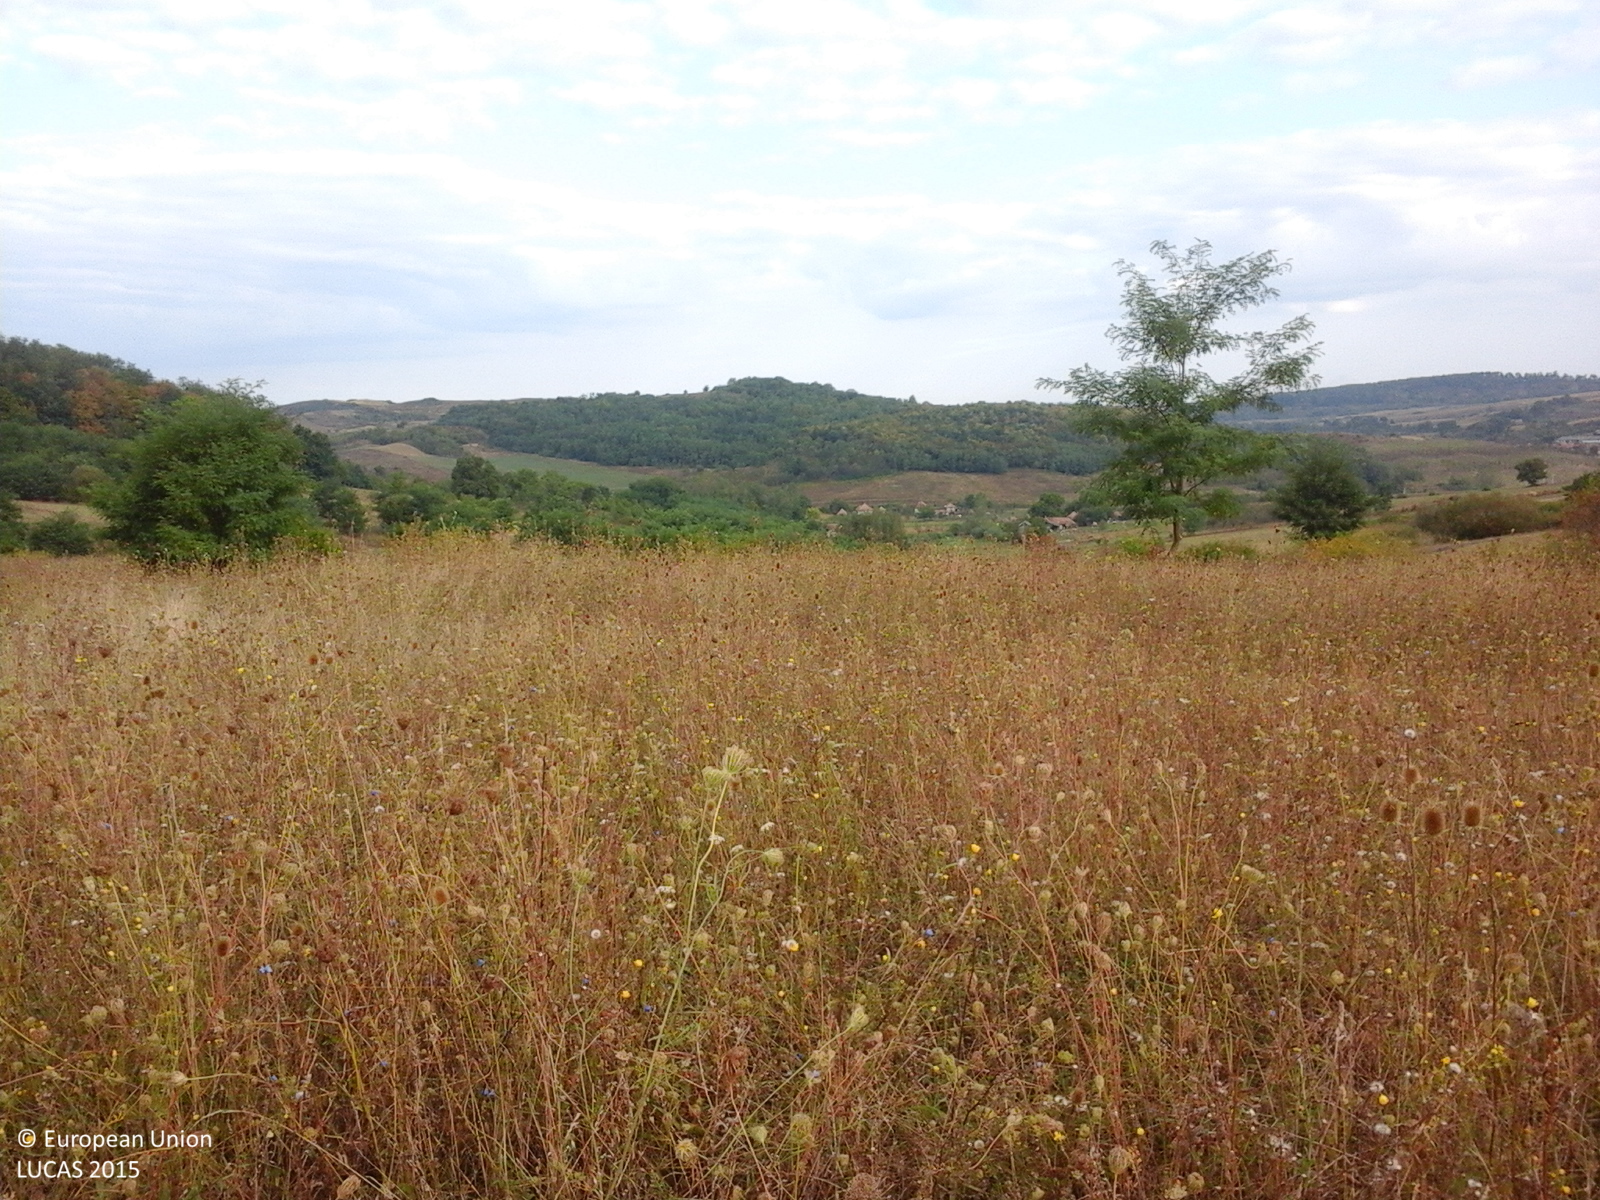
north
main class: Grassland
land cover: Grassland without tree/shrub cover
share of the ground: > 75 %
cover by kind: herbaceous plants 100 %
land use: Agriculture (excluding fallow land and kitchen gardens)
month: September
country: RO
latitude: 47.4008
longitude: 23.2529
